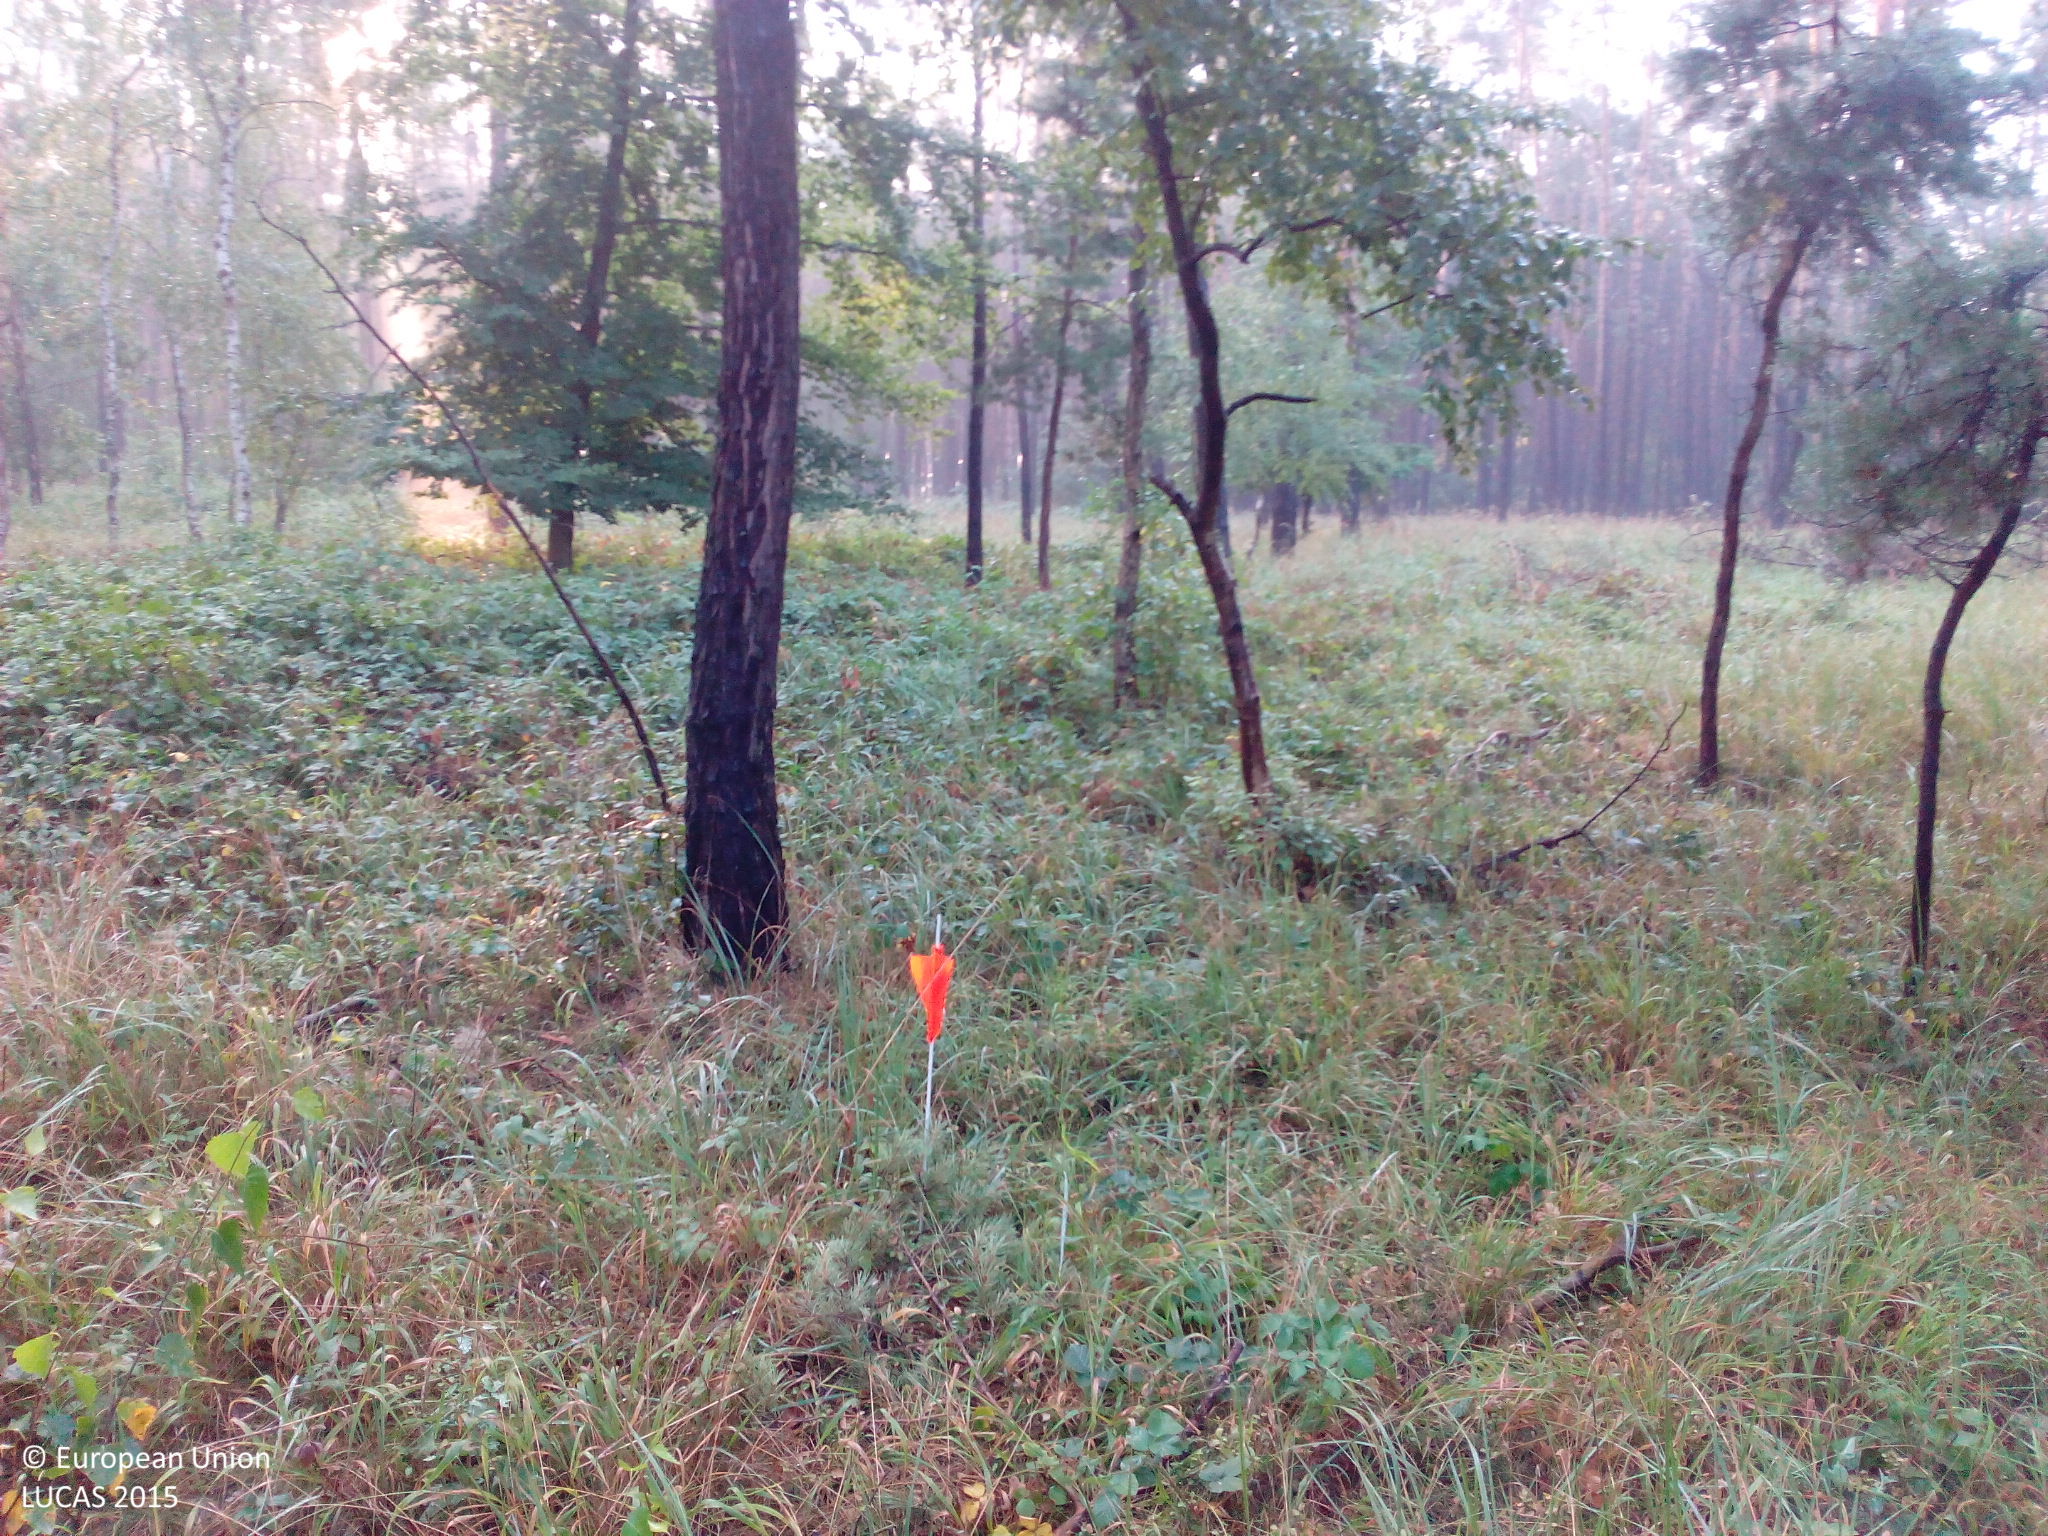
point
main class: Woodland
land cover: Pine dominated coniferous woodland
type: hemiboreal forest and nemoral coniferous forest and mixed broadleaved-coniferous forest
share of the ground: > 75 %
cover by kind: coniferous forest trees 75 %, broadleaved forest trees 10 %, herbaceous plants 10 %, shrubs 5 %
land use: Forestry
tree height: > 5 m
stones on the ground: < 10 %
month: August
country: DE
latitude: 51.6504
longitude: 12.4712
